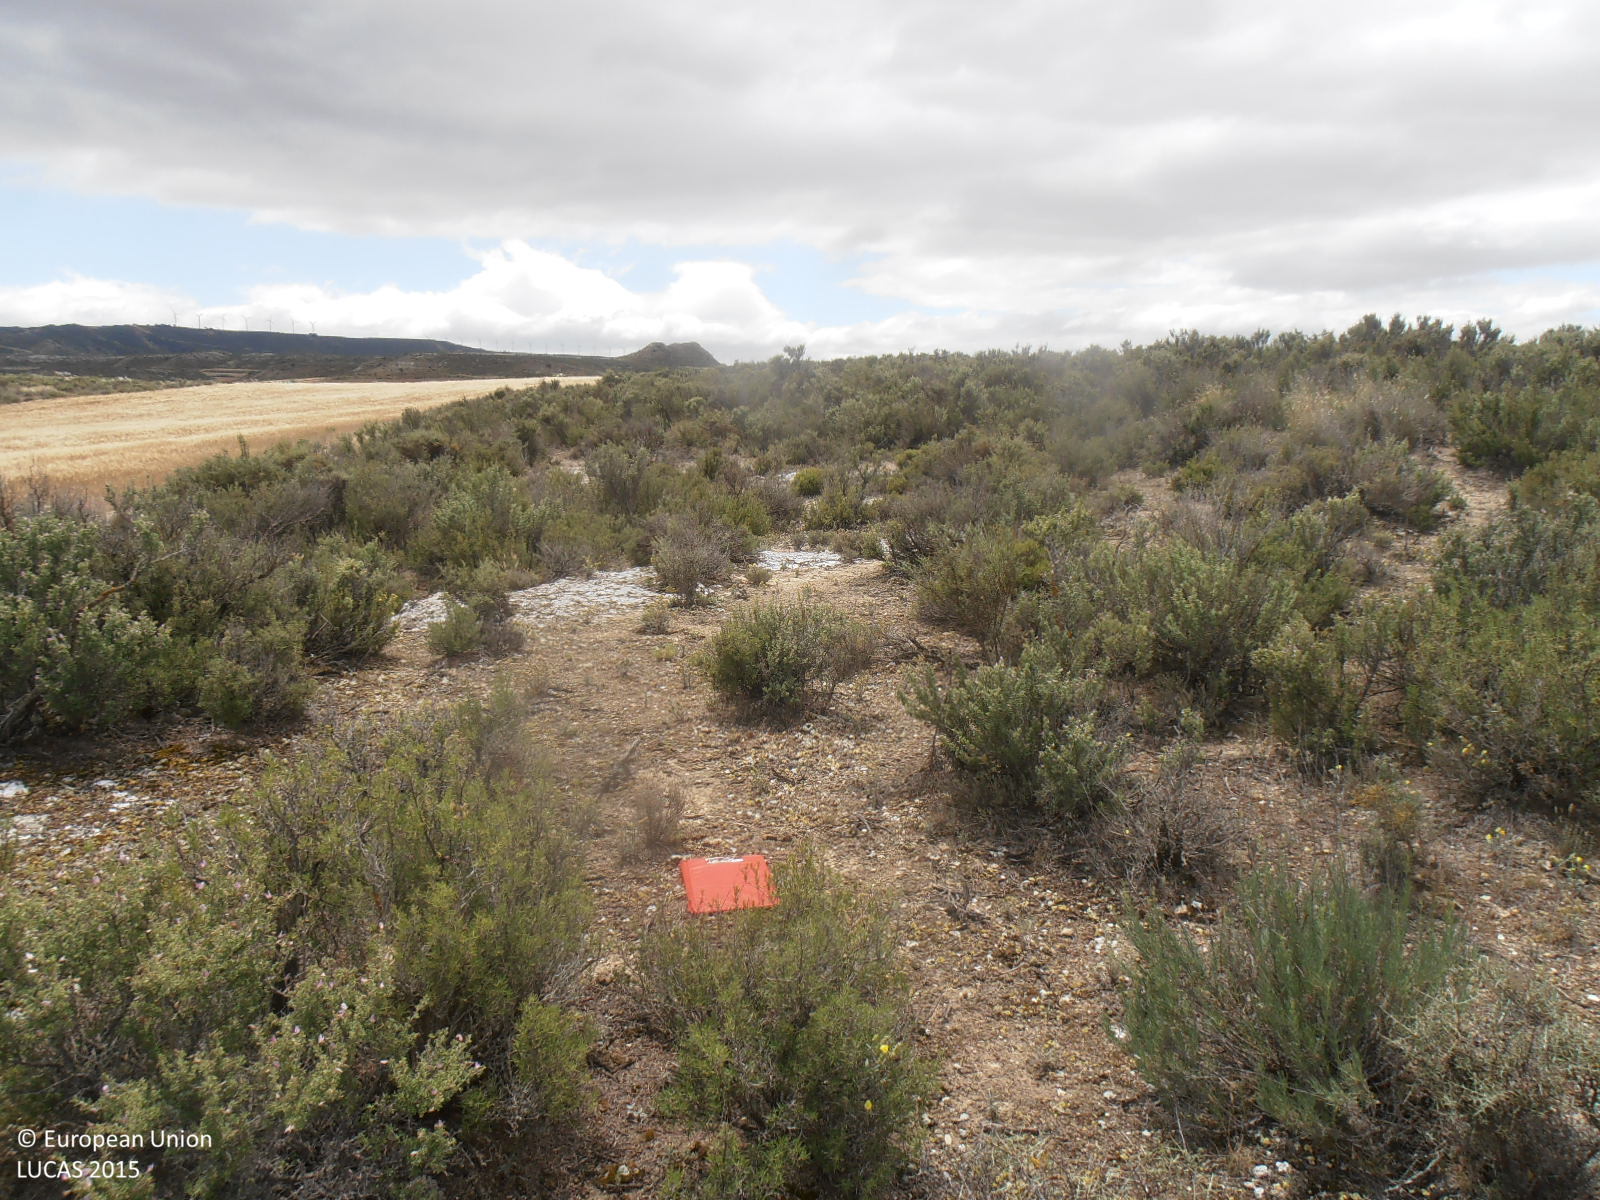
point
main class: Shrubland
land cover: Shrubland without tree cover
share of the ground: 50 - 75 %
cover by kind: shrubs 60 %, consolidated bare surface 40 %
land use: Semi-natural and natural areas not in use
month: June
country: ES
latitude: 41.9317
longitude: -1.1092
